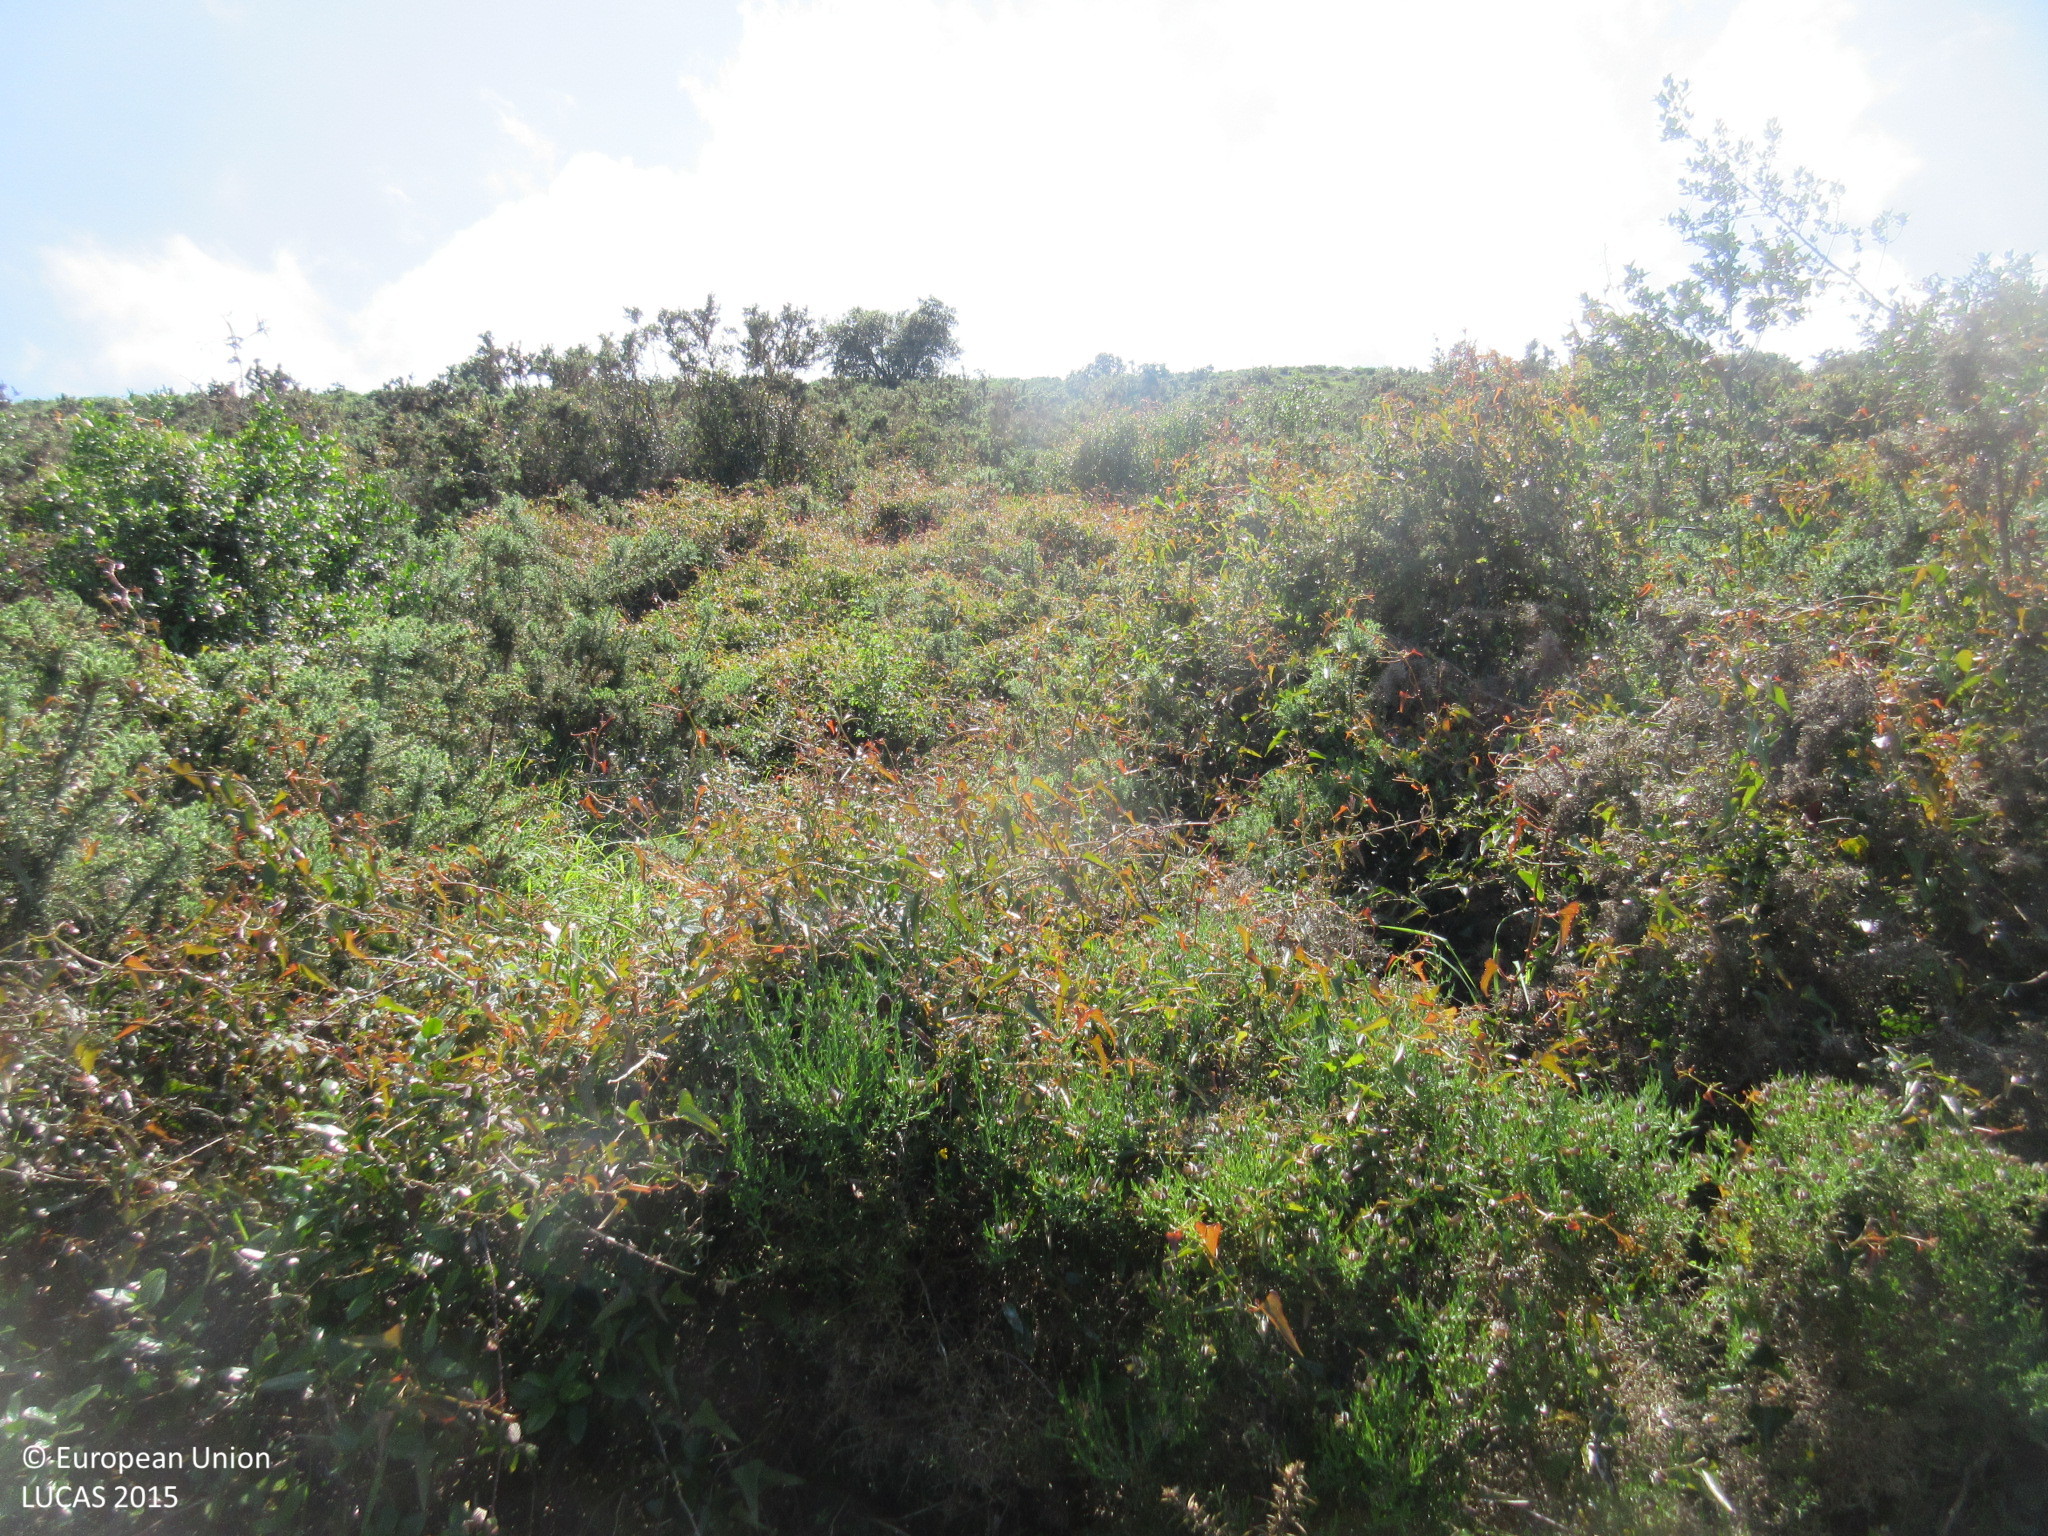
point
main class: Shrubland
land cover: Shrubland with sparse tree cover
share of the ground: > 75 %
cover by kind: shrubs 95 %, broadleaved forest trees 5 %
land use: Agriculture (excluding fallow land and kitchen gardens)
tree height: < 5 m
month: May
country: ES
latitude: 43.3433
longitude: -4.5052
